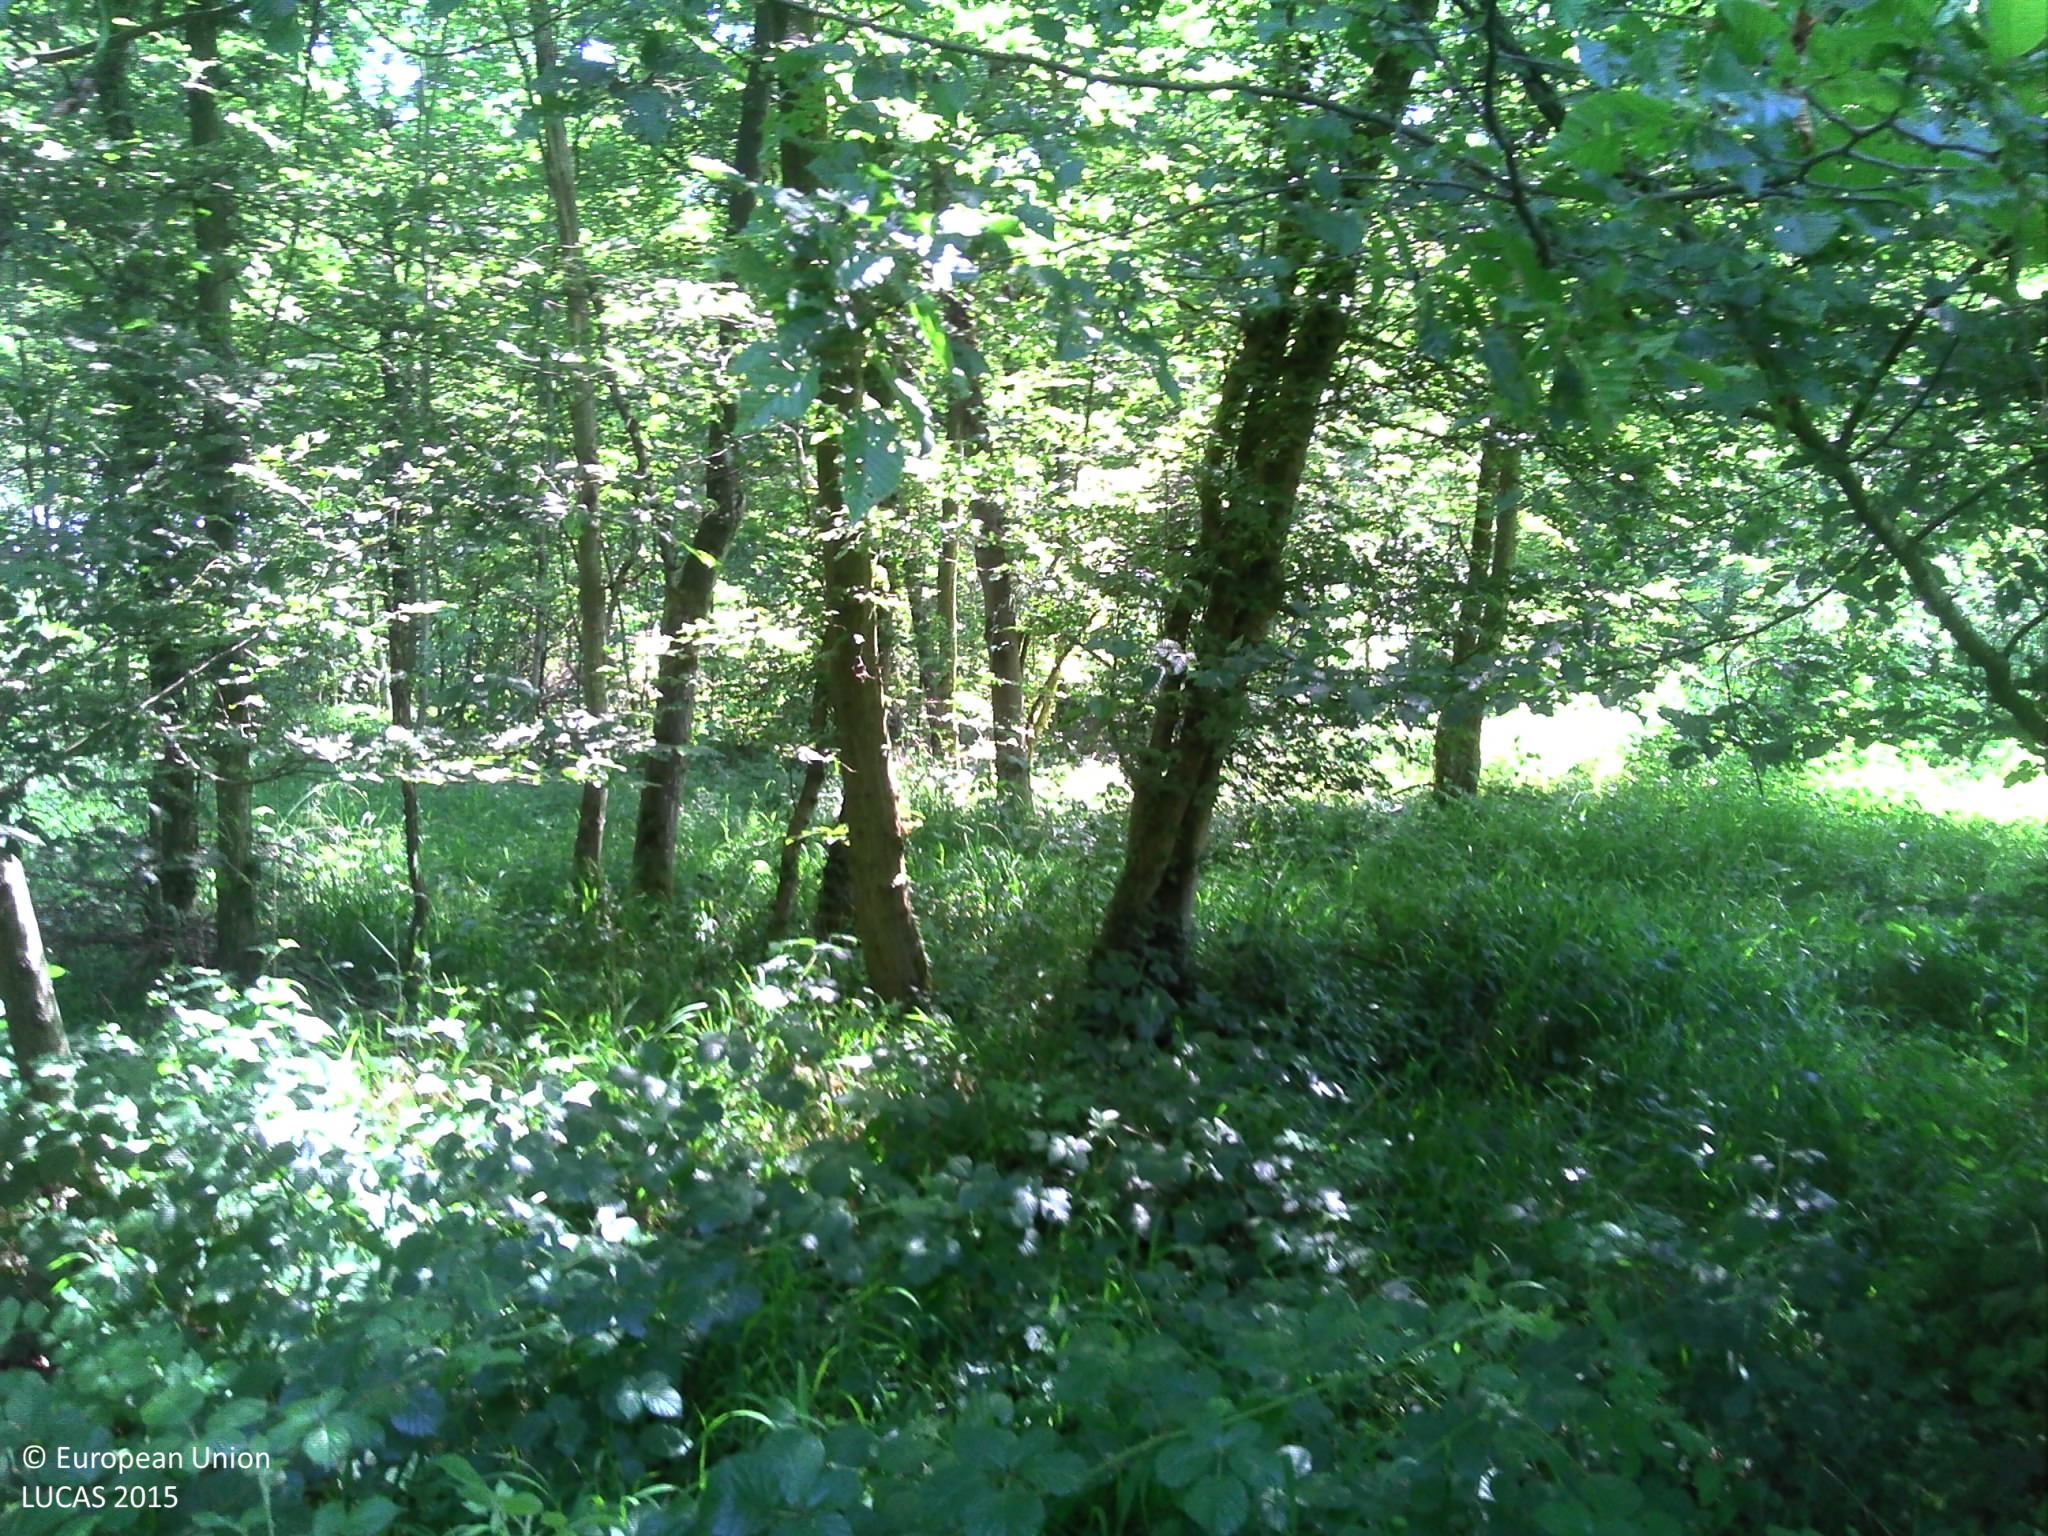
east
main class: Woodland
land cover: Broadleaved woodland
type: mesophytic deciduous forest
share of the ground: > 75 %
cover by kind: broadleaved forest trees 80 %, herbaceous plants 20 %
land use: Forestry
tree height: > 5 m
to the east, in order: Broadleaved woodland; Inland fresh running water; Spontaneously vegetated surfaces; Fences; Inland fresh water bodies
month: June
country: FR
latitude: 48.4154
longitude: 7.6905
